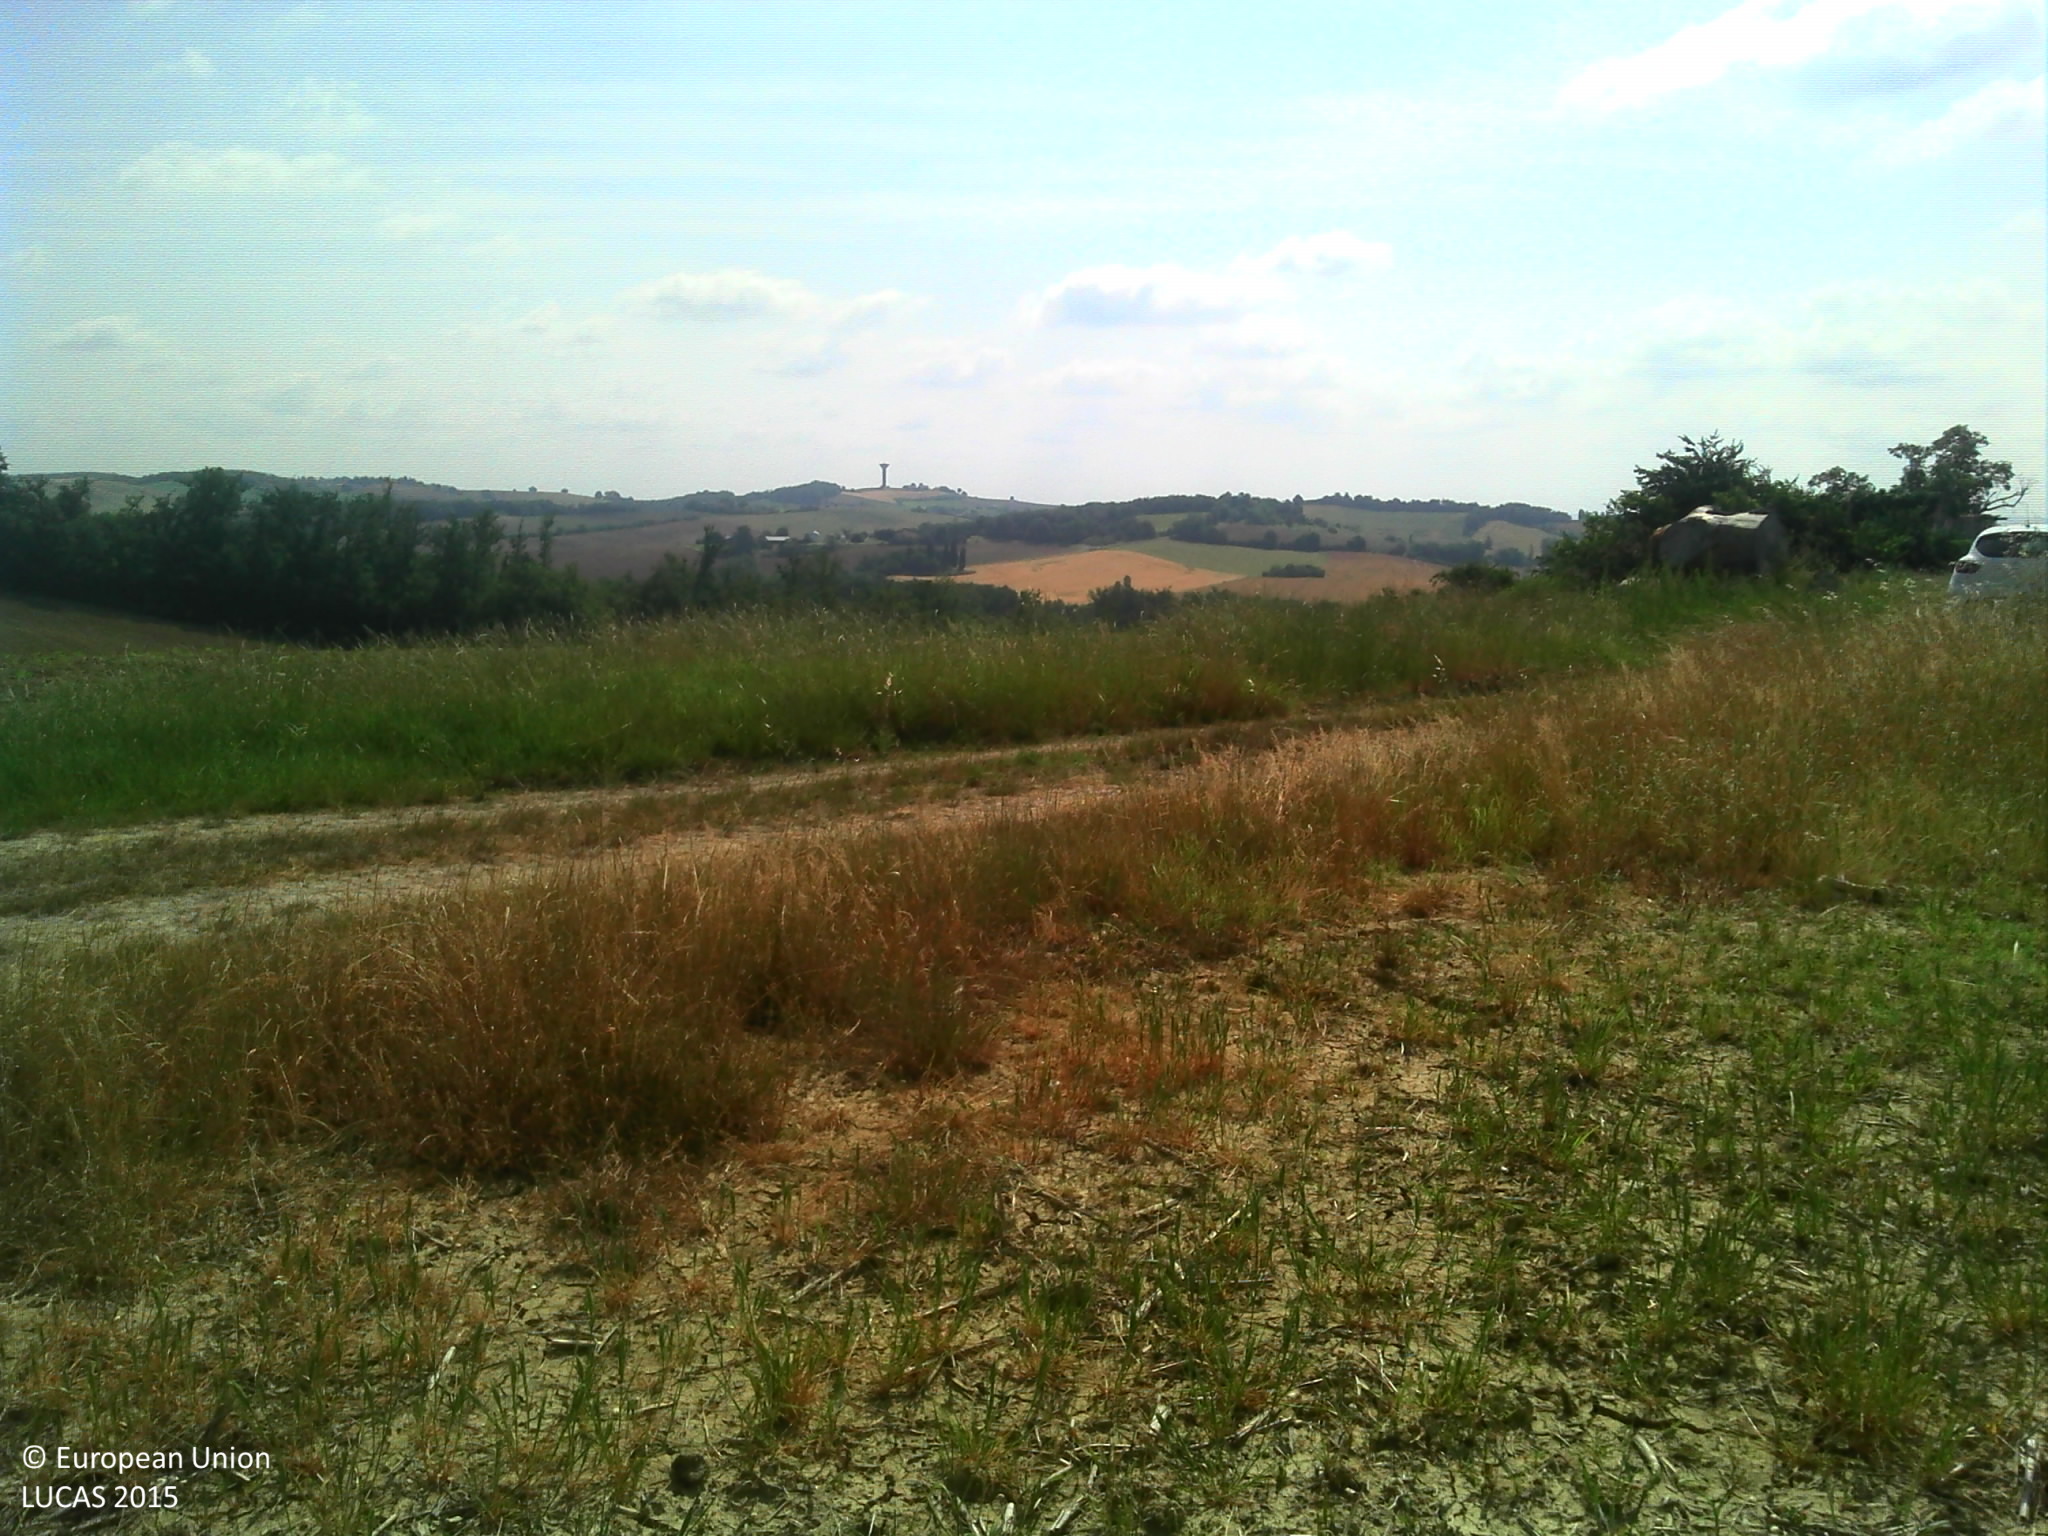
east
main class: Cropland
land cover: Common wheat
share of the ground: 50 - 75 %
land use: Agriculture (excluding fallow land and kitchen gardens)
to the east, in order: Common wheat; Grass margins; Tracks; Grass margins; Sunflower; Grassland without tree/shrub cover; Electric lines; Broadleaved woodland
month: June
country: FR
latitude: 43.8728
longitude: 1.7020
